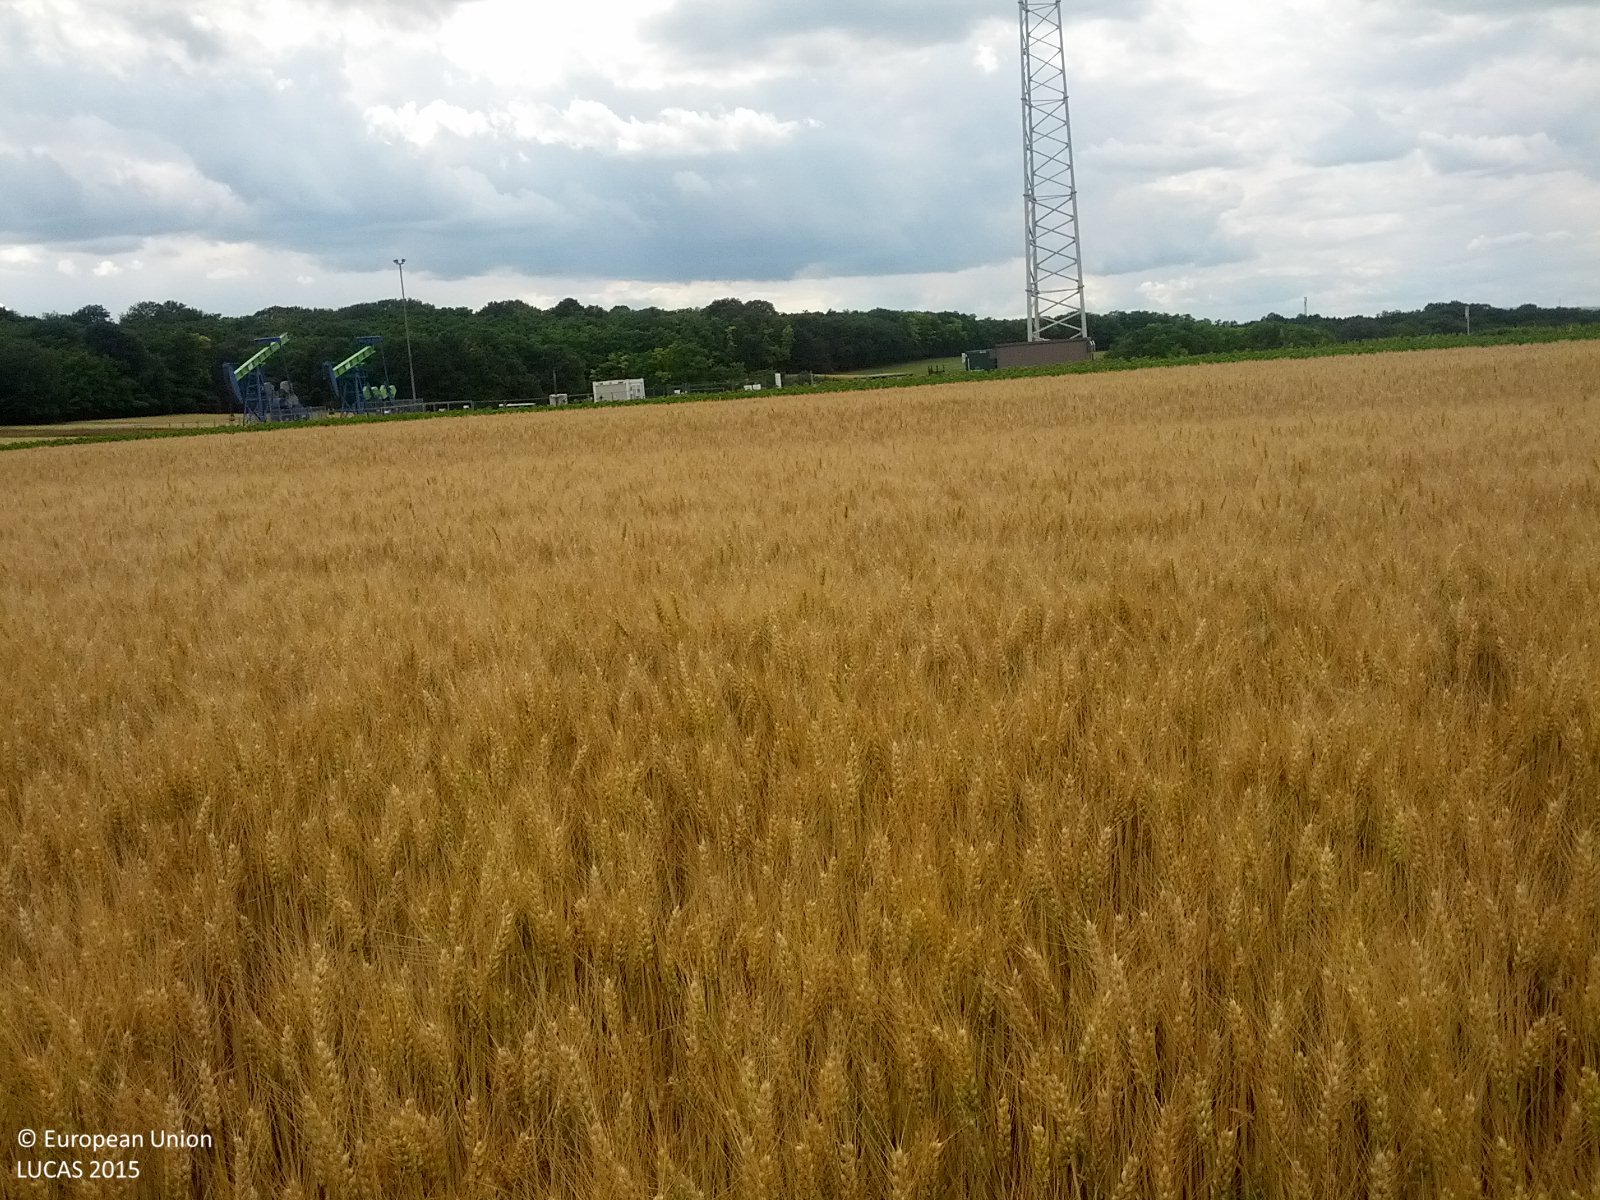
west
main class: Cropland
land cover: Common wheat
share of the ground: > 75 %
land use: Agriculture (excluding fallow land and kitchen gardens)
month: June
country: AT
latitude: 48.4285
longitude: 16.8050
